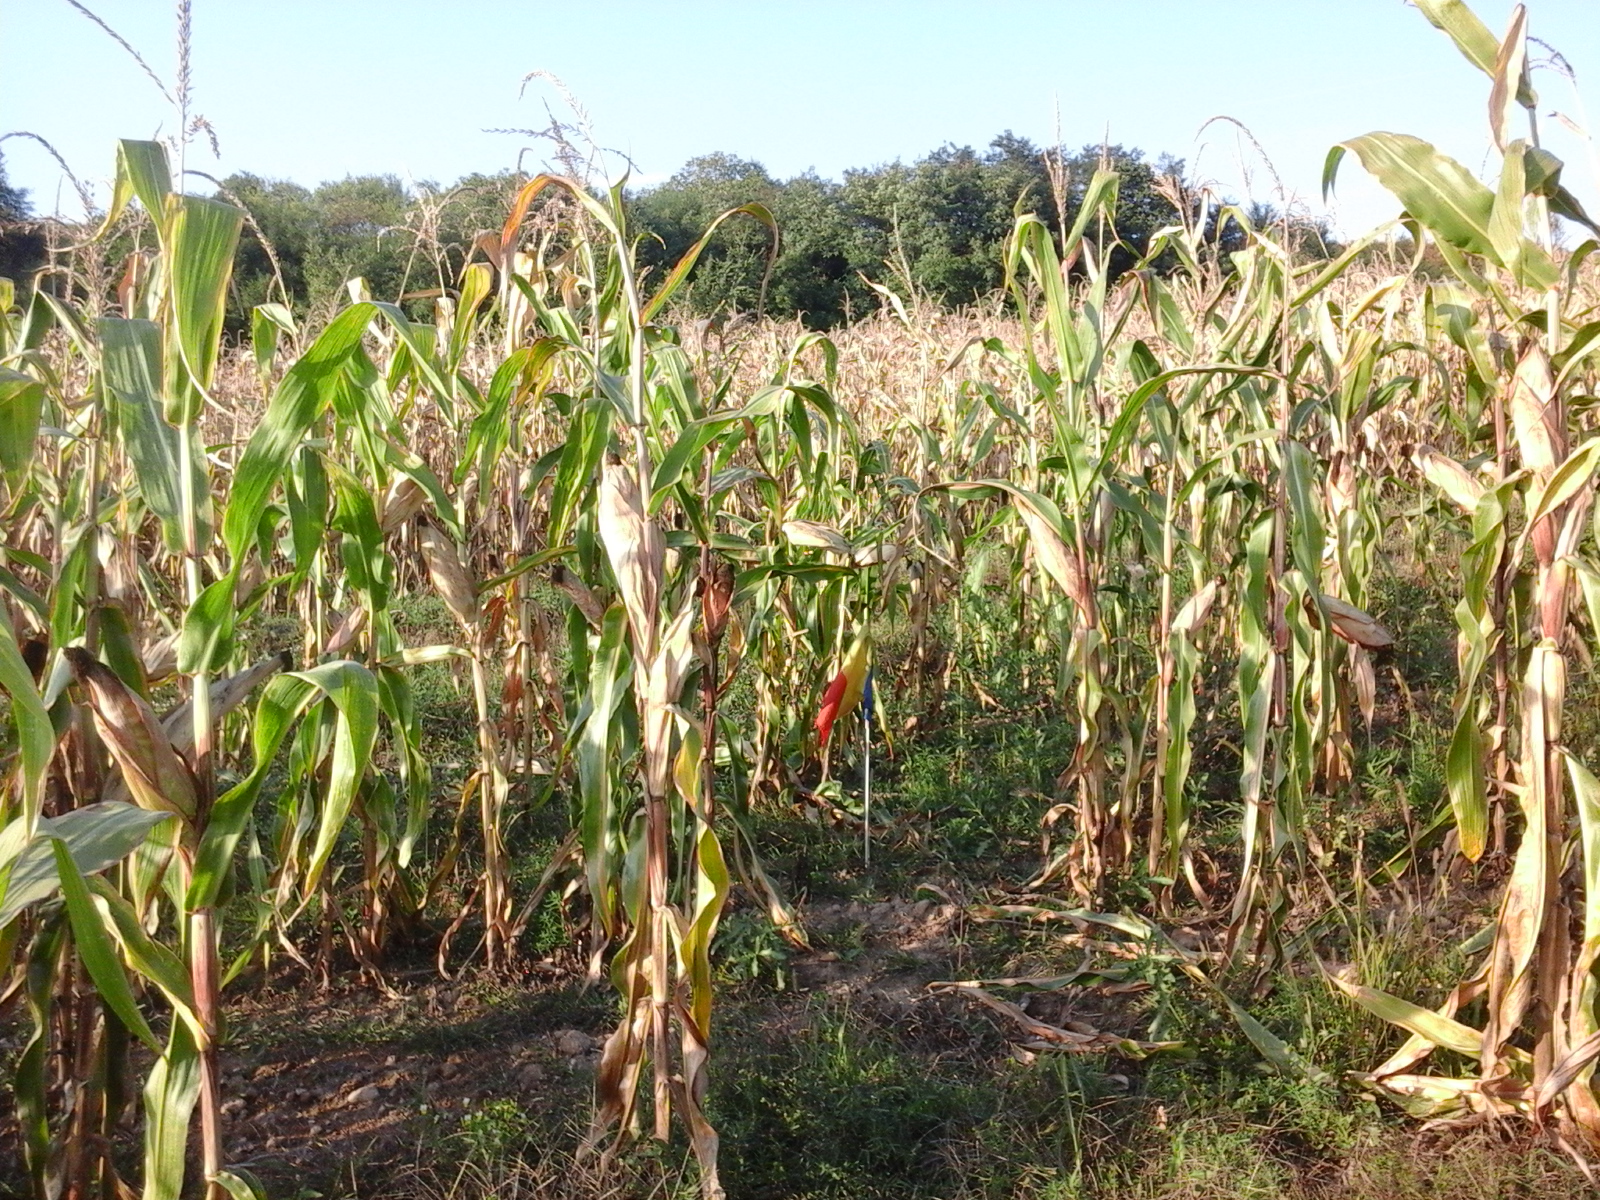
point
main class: Cropland
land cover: Maize
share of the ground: > 75 %
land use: Agriculture (excluding fallow land and kitchen gardens)
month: September
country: RO
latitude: 46.5577
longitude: 22.5355
